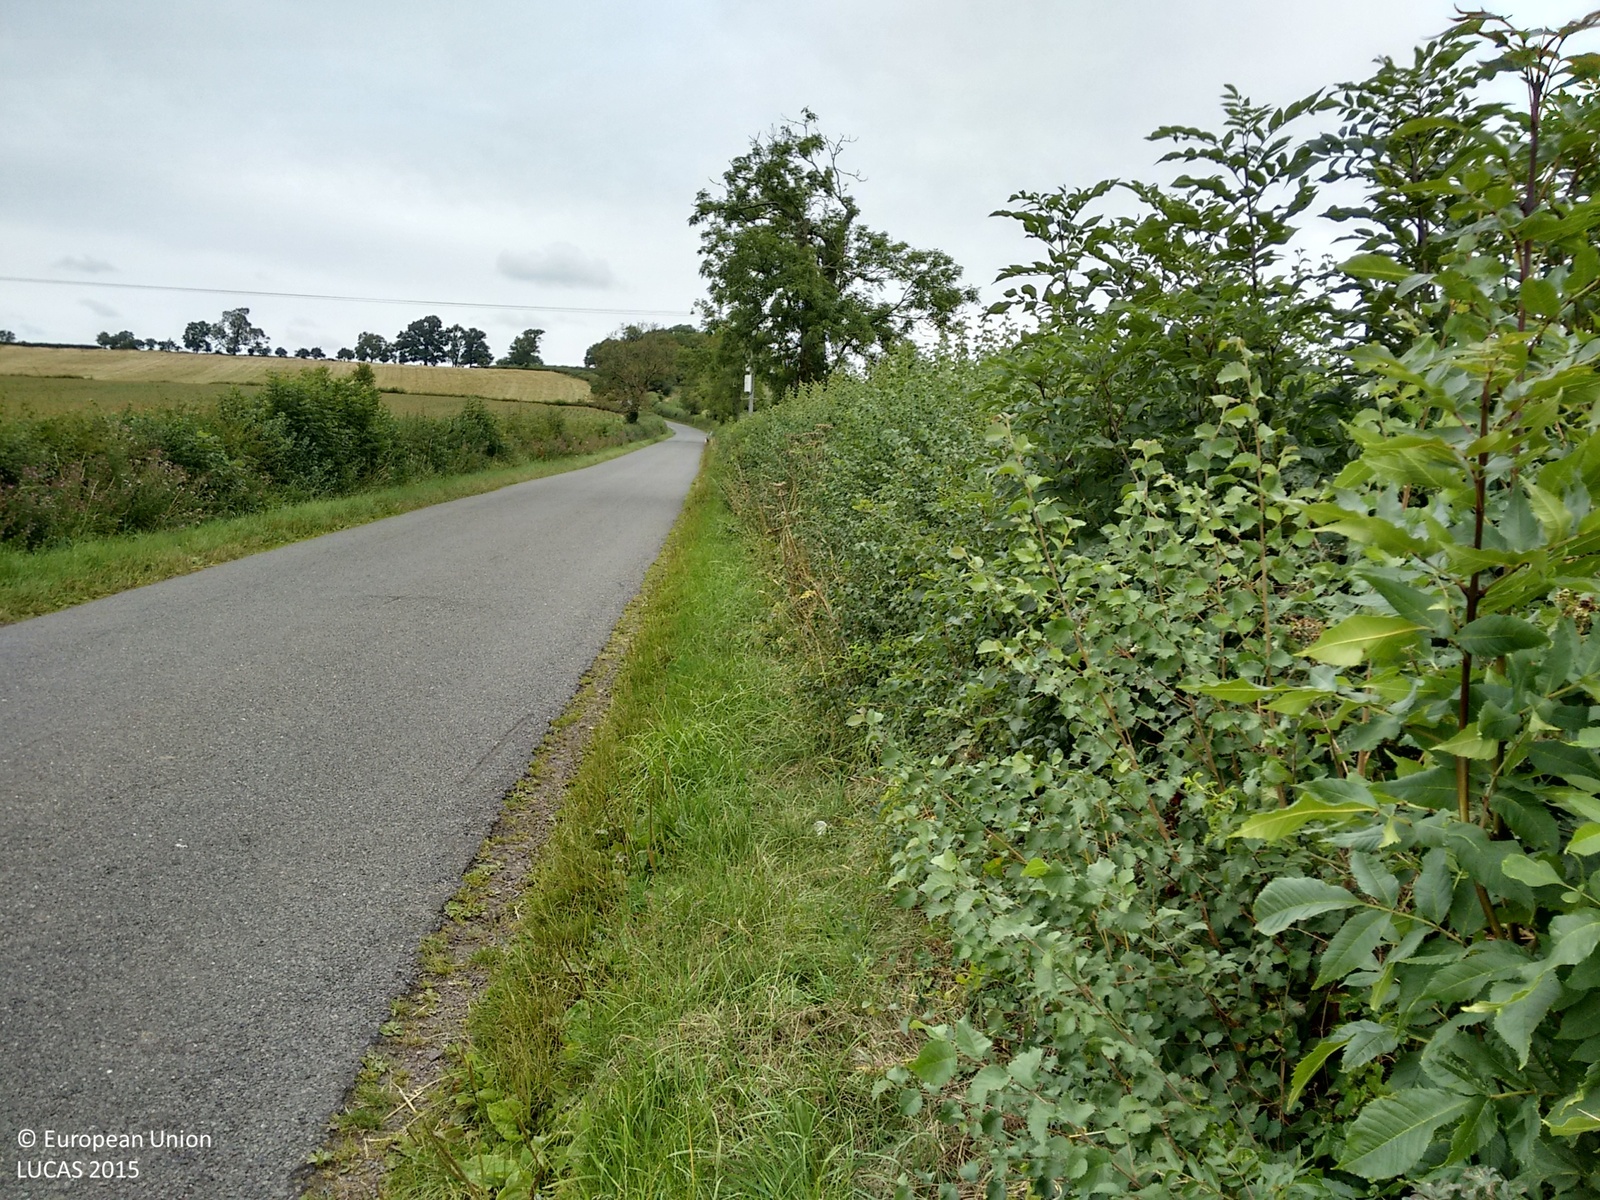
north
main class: Cropland
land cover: Maize
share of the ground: > 75 %
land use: Agriculture (excluding fallow land and kitchen gardens)
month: August
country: GB
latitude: 52.0806
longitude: -1.2101
